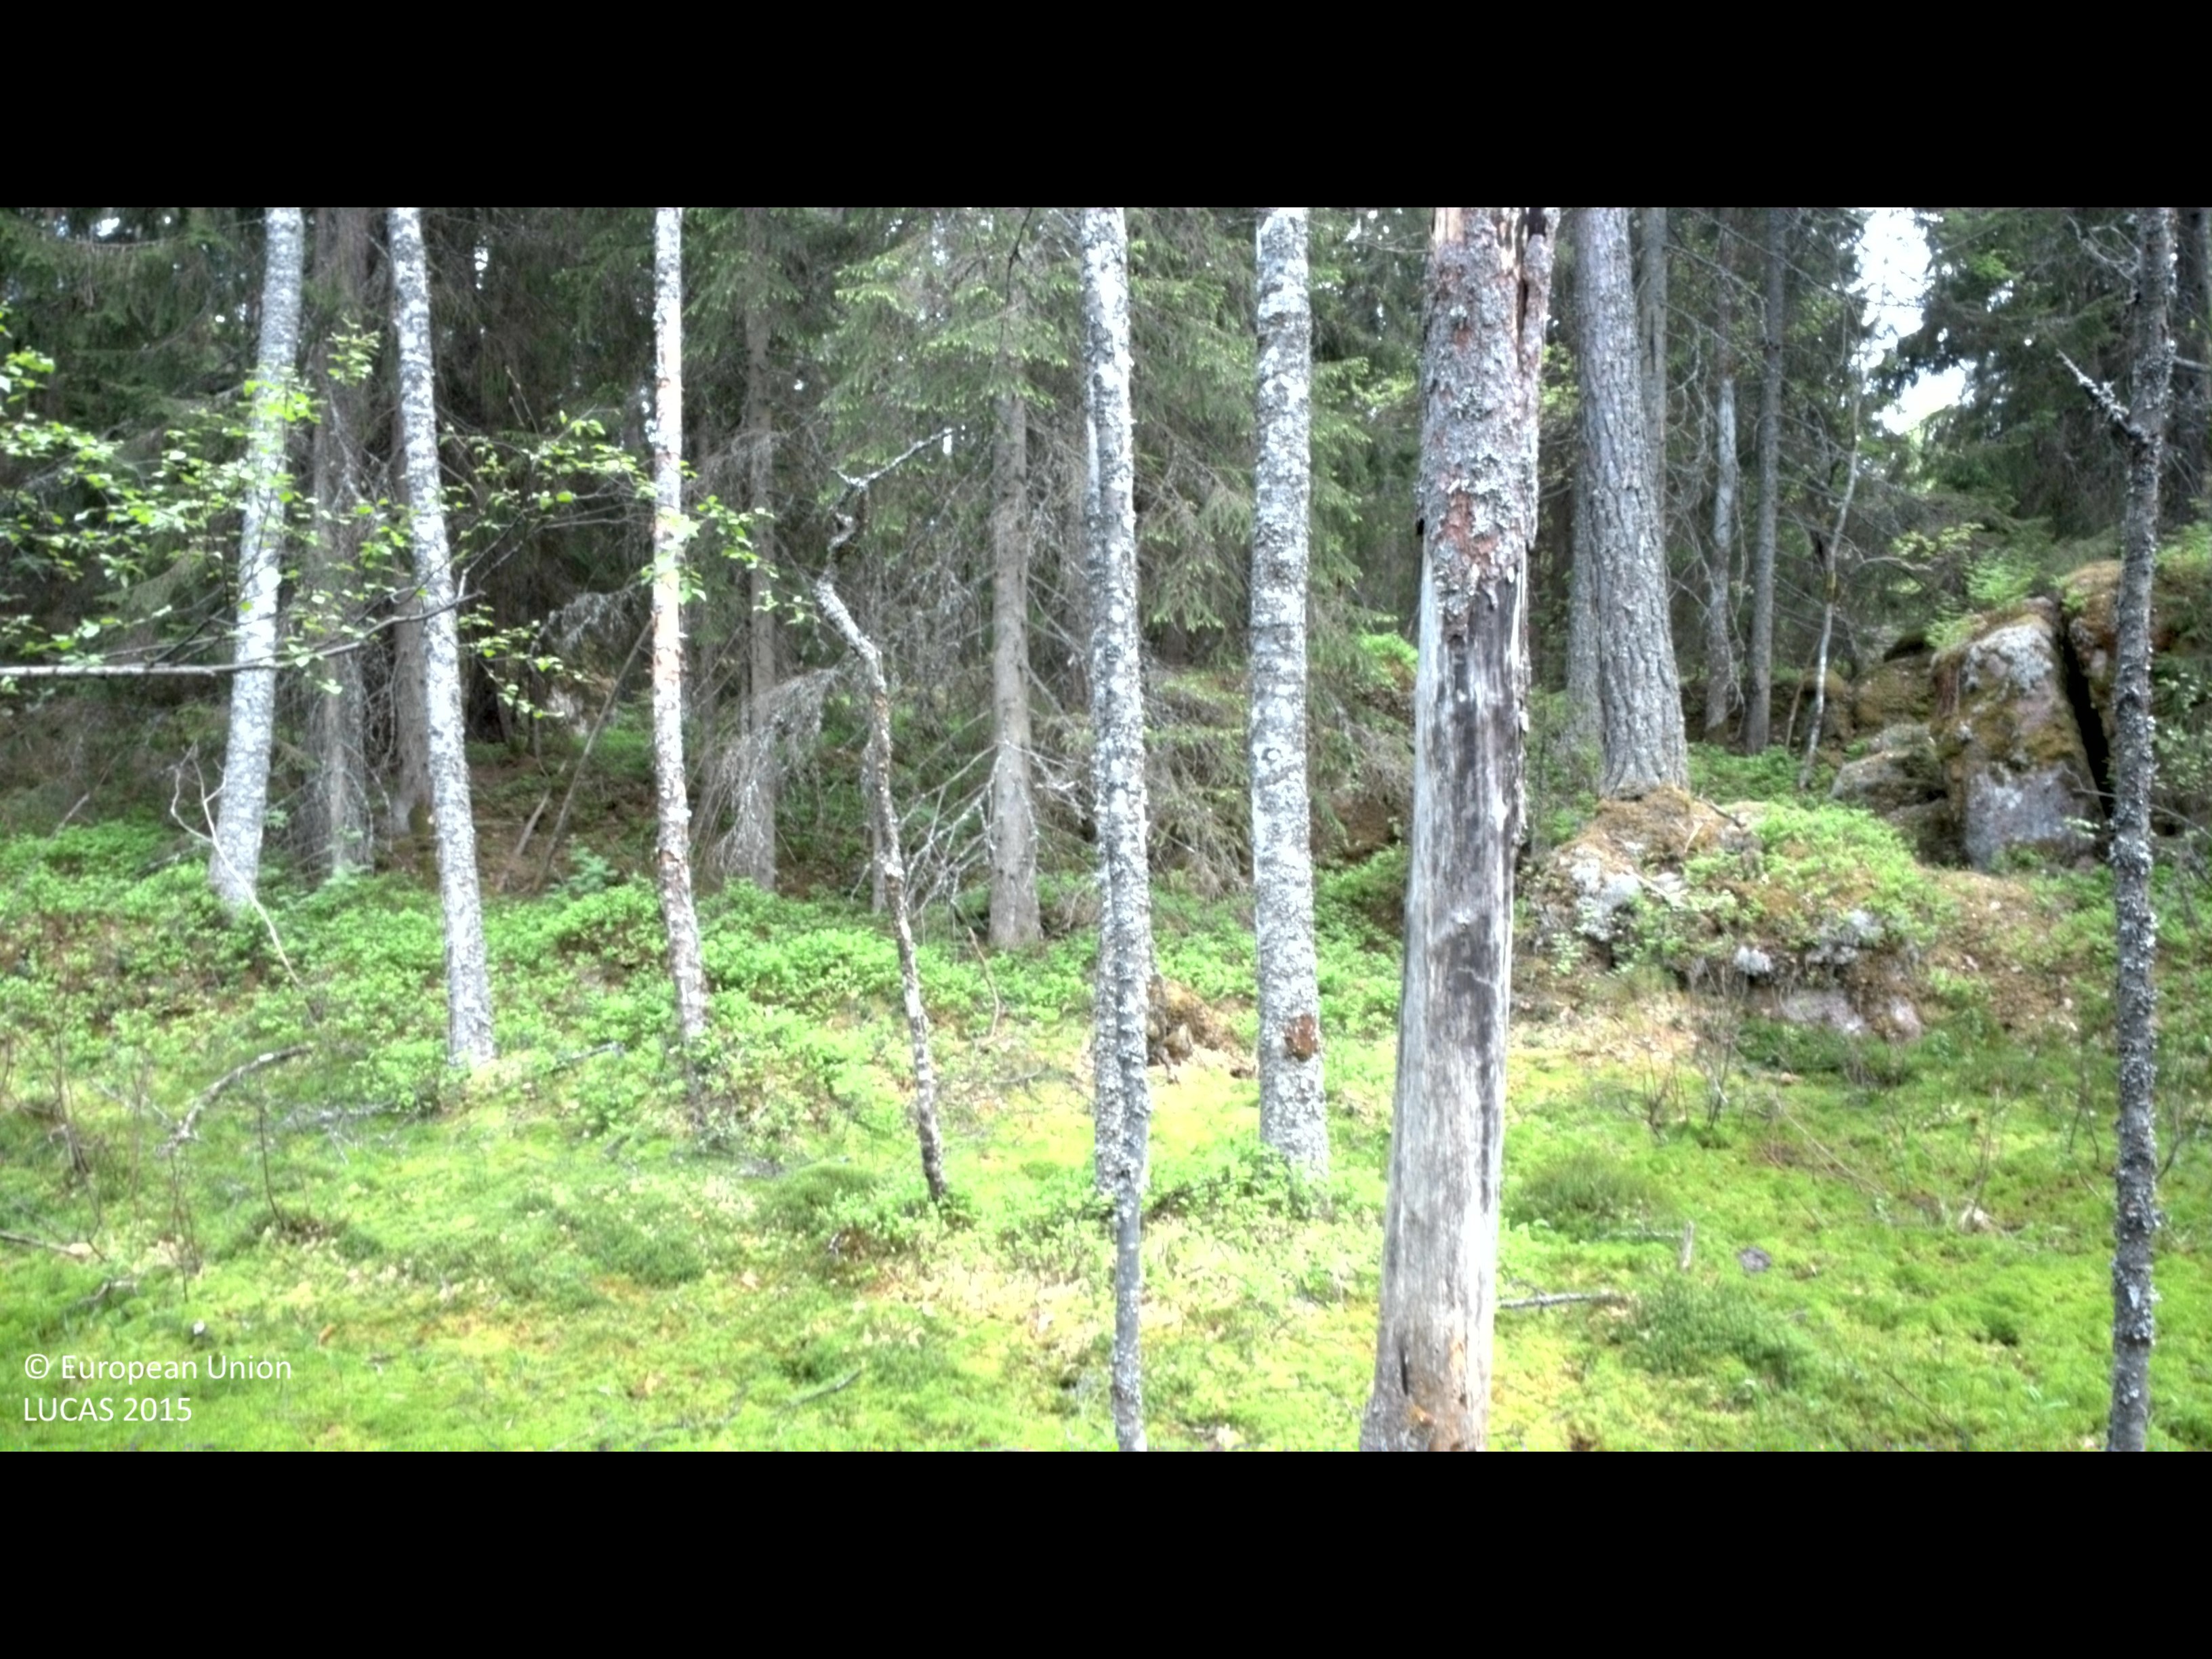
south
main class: Woodland
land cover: Pine dominated mixed woodland
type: boreal forest
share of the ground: > 75 %
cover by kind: coniferous forest trees 60 %, broadleaved forest trees 20 %, shrubs 10 %, lichens and mosses 10 %
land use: Forestry
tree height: > 5 m
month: May
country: SE
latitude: 57.3548
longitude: 16.1984
